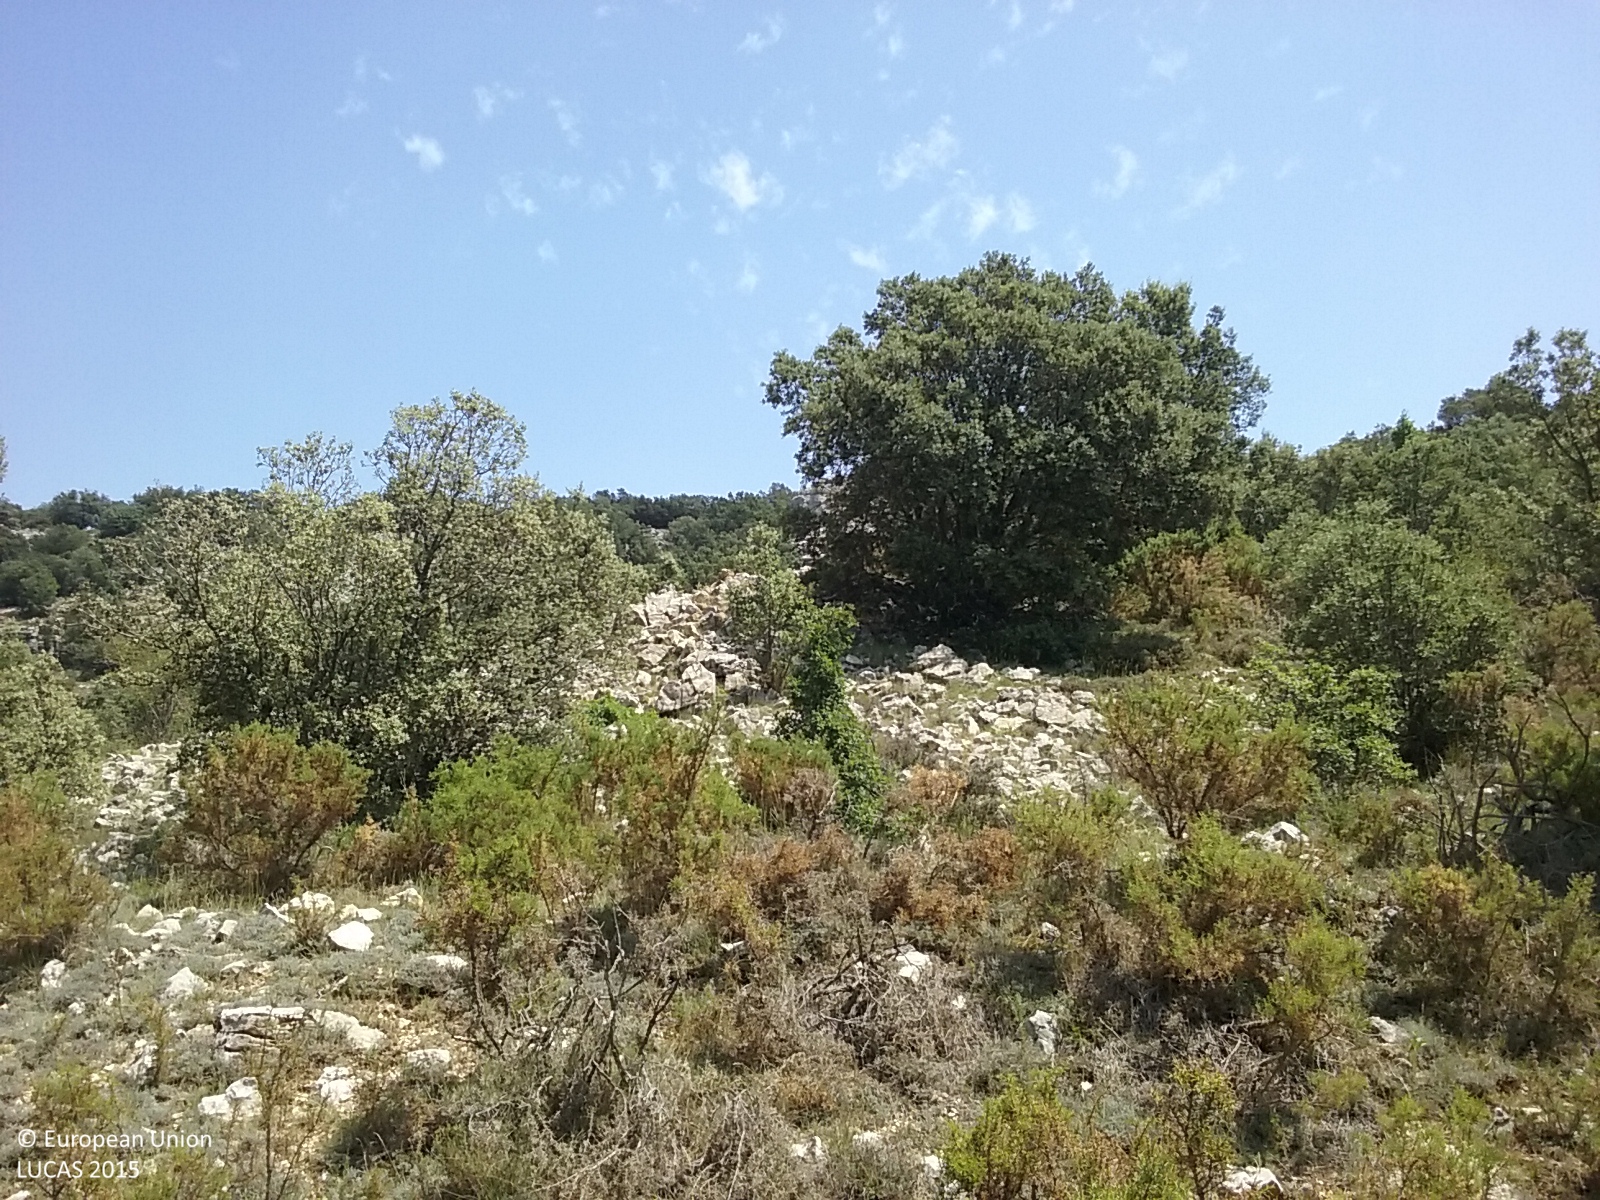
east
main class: Woodland
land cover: Broadleaved woodland
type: broadleaved evergreen forest
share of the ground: 50 - 75 %
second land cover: Shrubland without tree cover
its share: 25 - 50 %
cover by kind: broadleaved forest trees 60 %, shrubs 20 %, herbaceous plants 20 %
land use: Forestry
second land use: Agriculture (excluding fallow land and kitchen gardens)
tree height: > 5 m
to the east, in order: Broadleaved woodland; Shrubland without tree cover; Dry stone walls; Broadleaved woodland
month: August
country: ES
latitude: 40.4183
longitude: -0.1056
